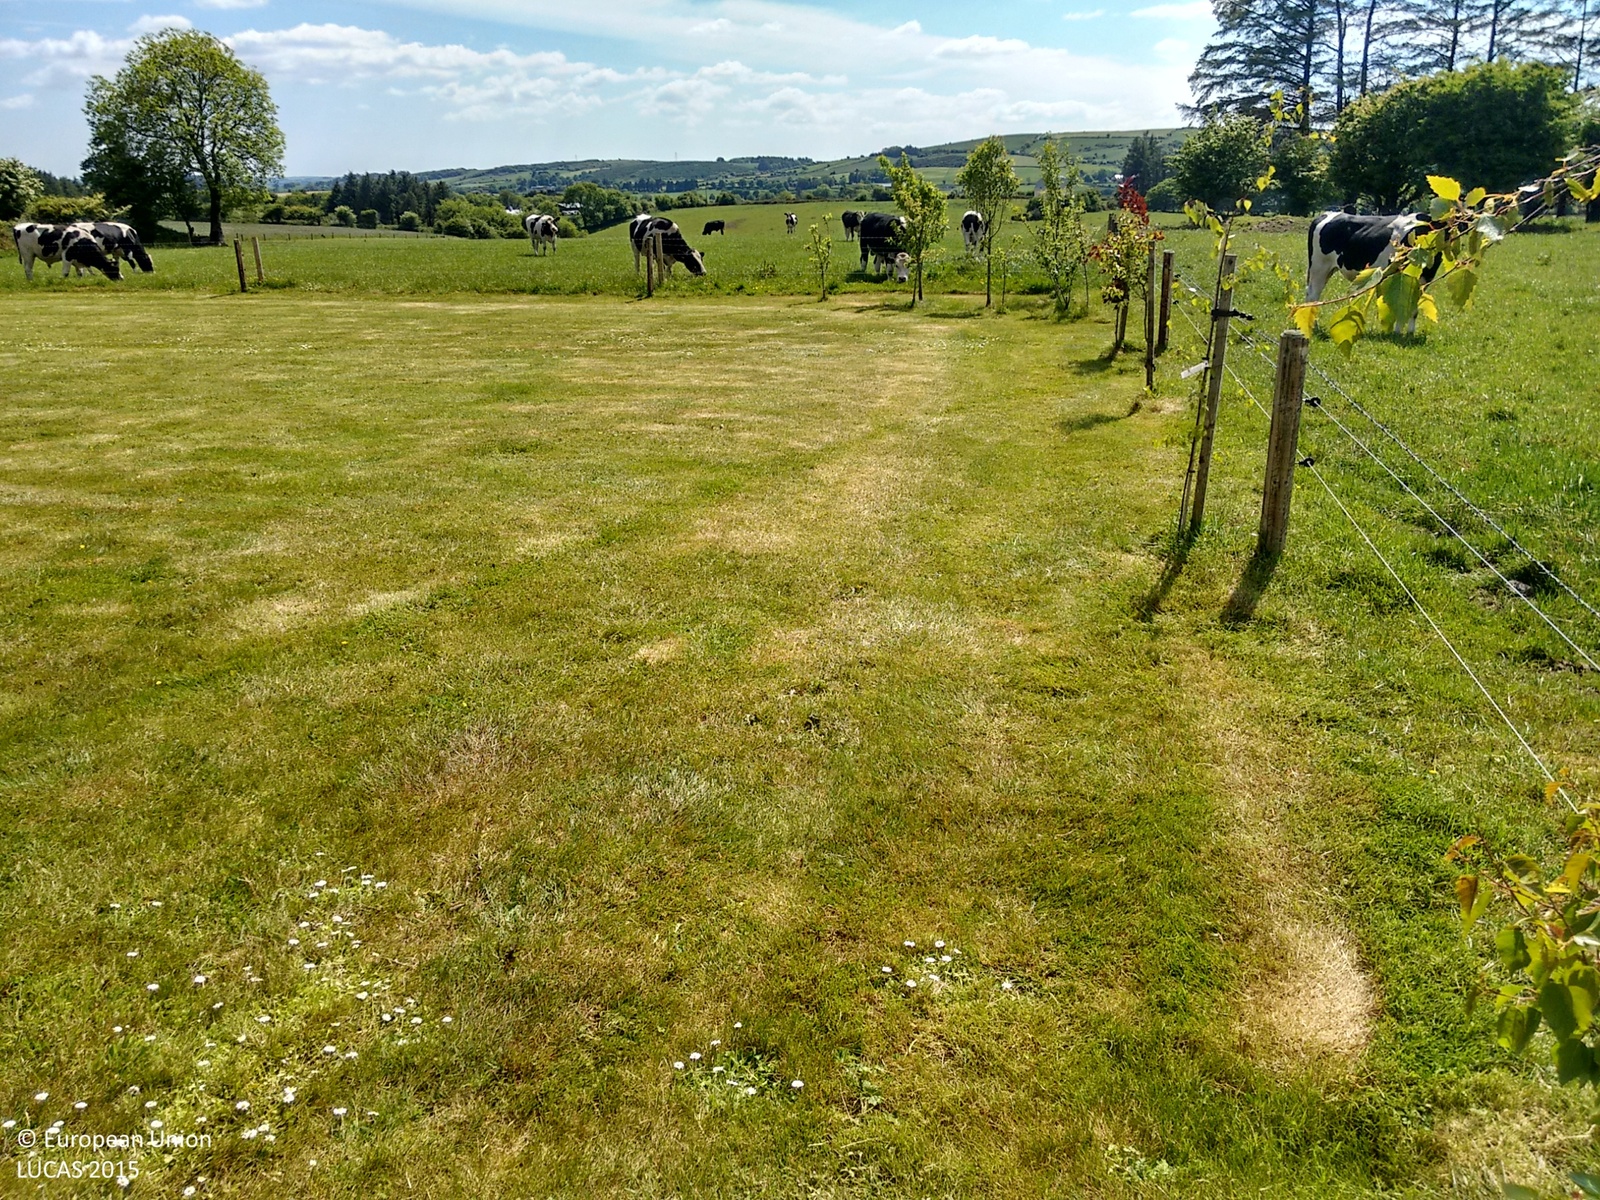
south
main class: Grassland
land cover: Grassland without tree/shrub cover
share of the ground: > 75 %
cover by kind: herbaceous plants 95 %, shrubs 5 %
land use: Agriculture (excluding fallow land and kitchen gardens)
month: June
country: IE
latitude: 51.9785
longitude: -8.8270
